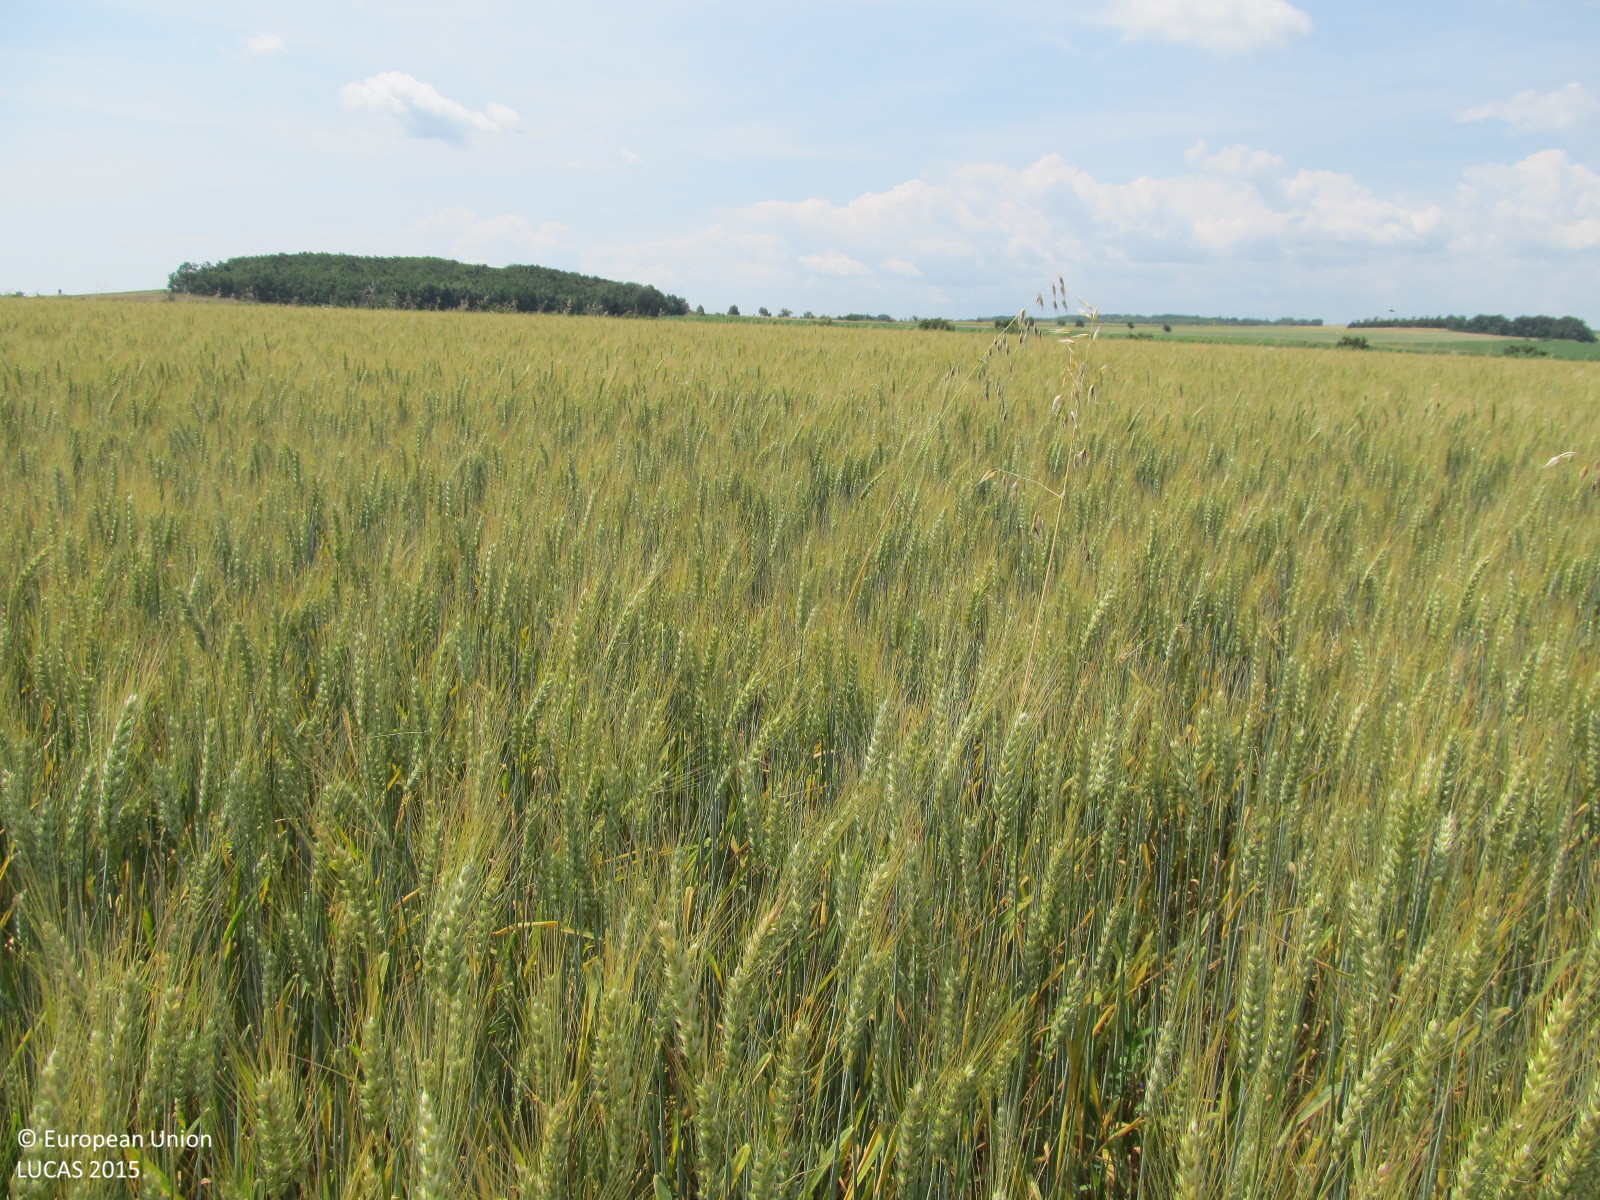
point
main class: Cropland
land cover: Common wheat
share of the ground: > 75 %
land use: Agriculture (excluding fallow land and kitchen gardens)
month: June
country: AT
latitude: 48.6288
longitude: 15.8246
